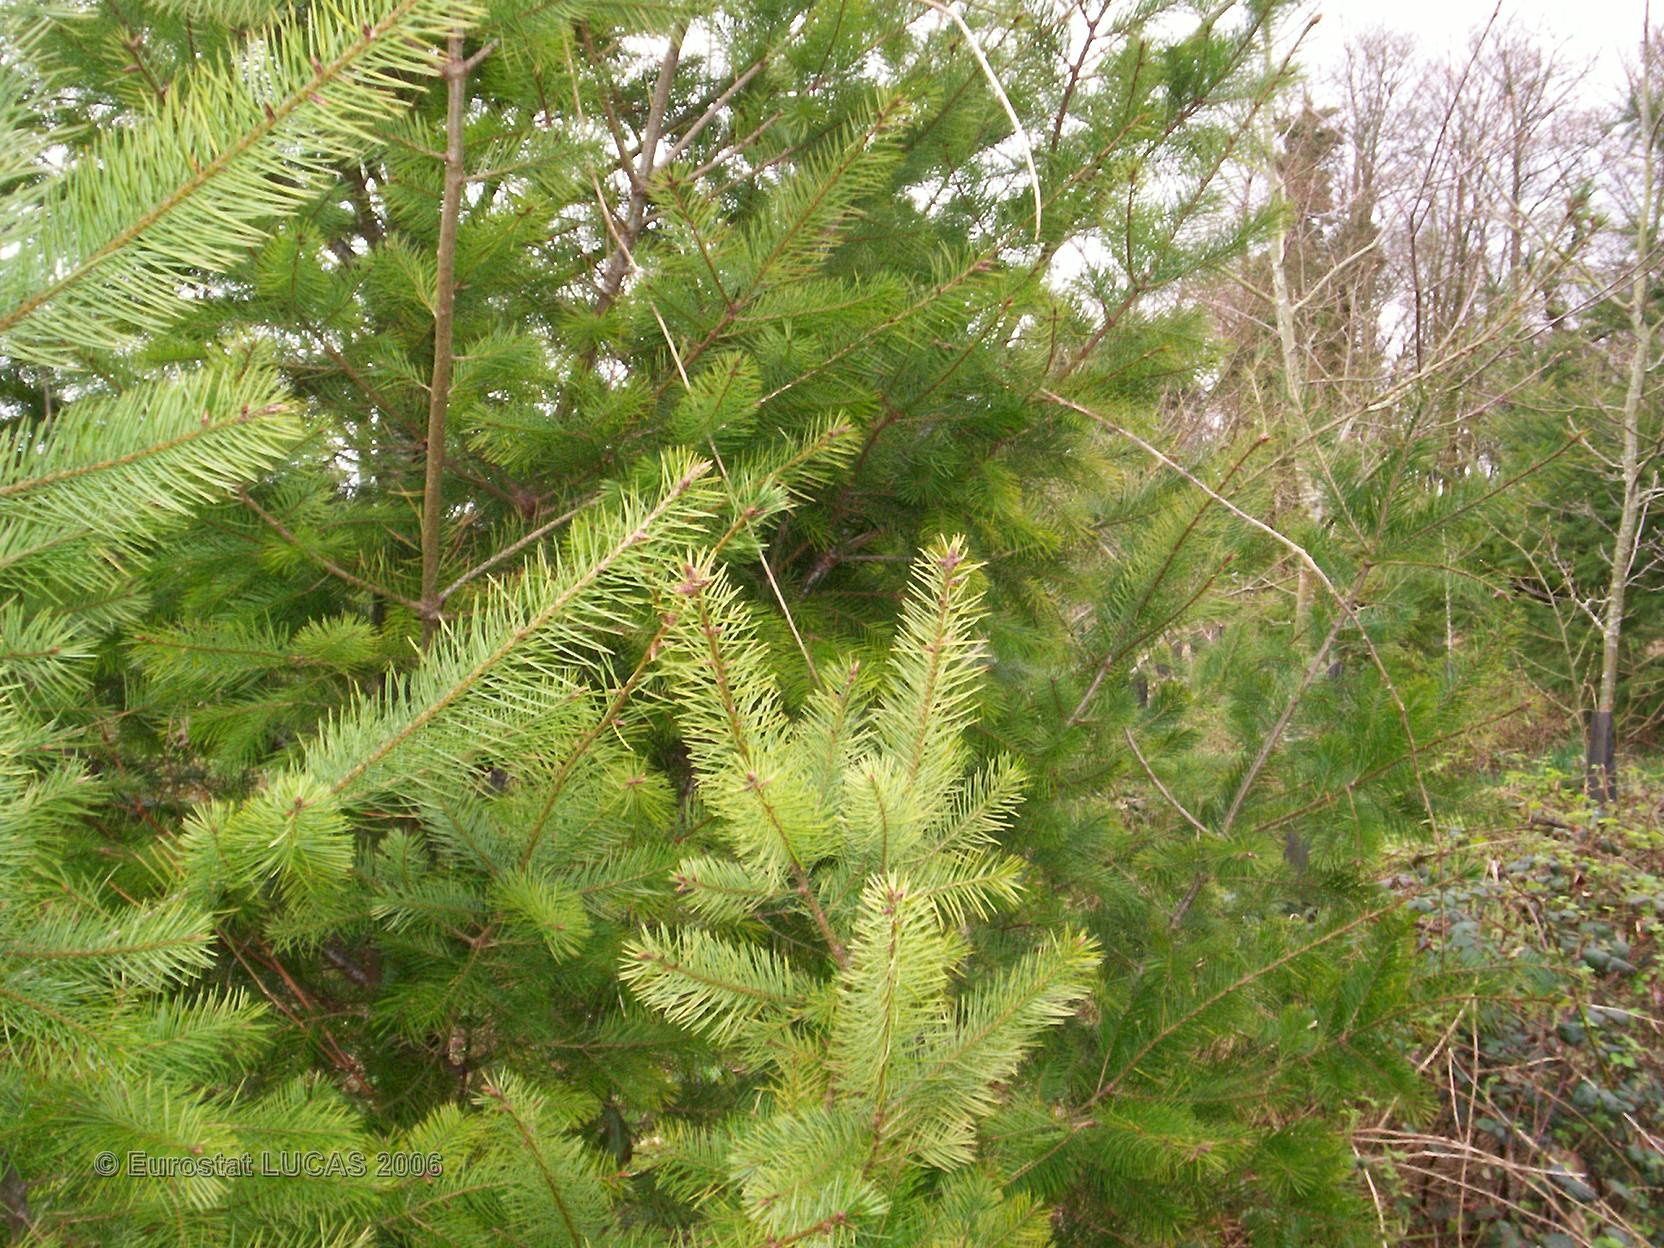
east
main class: Woodland
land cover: Coniferous forest
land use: Forestry
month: April
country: FR
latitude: 47.9961
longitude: -3.6007
